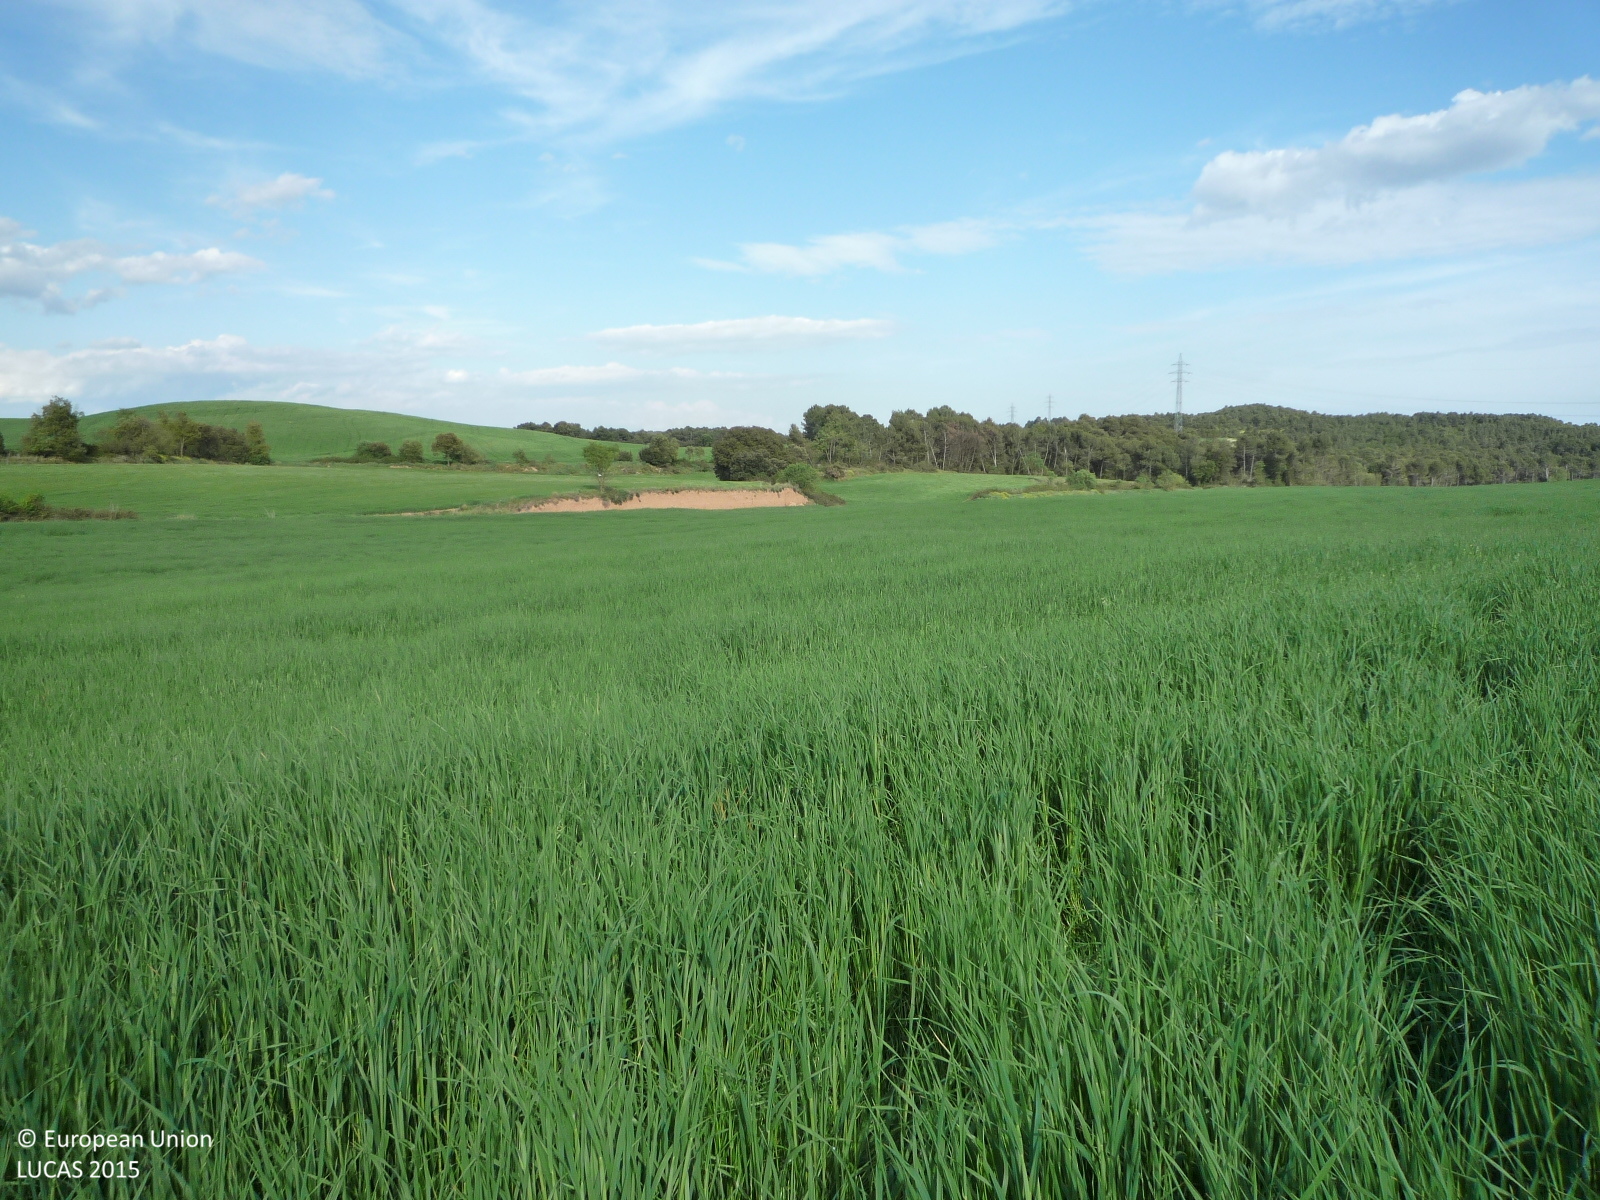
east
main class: Cropland
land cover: Oats
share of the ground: > 75 %
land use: Agriculture (excluding fallow land and kitchen gardens)
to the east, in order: Oats; Grass margins; Barley; Grass margins; Broadleaved woodland
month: April
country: ES
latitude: 41.7467
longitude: 1.6571
